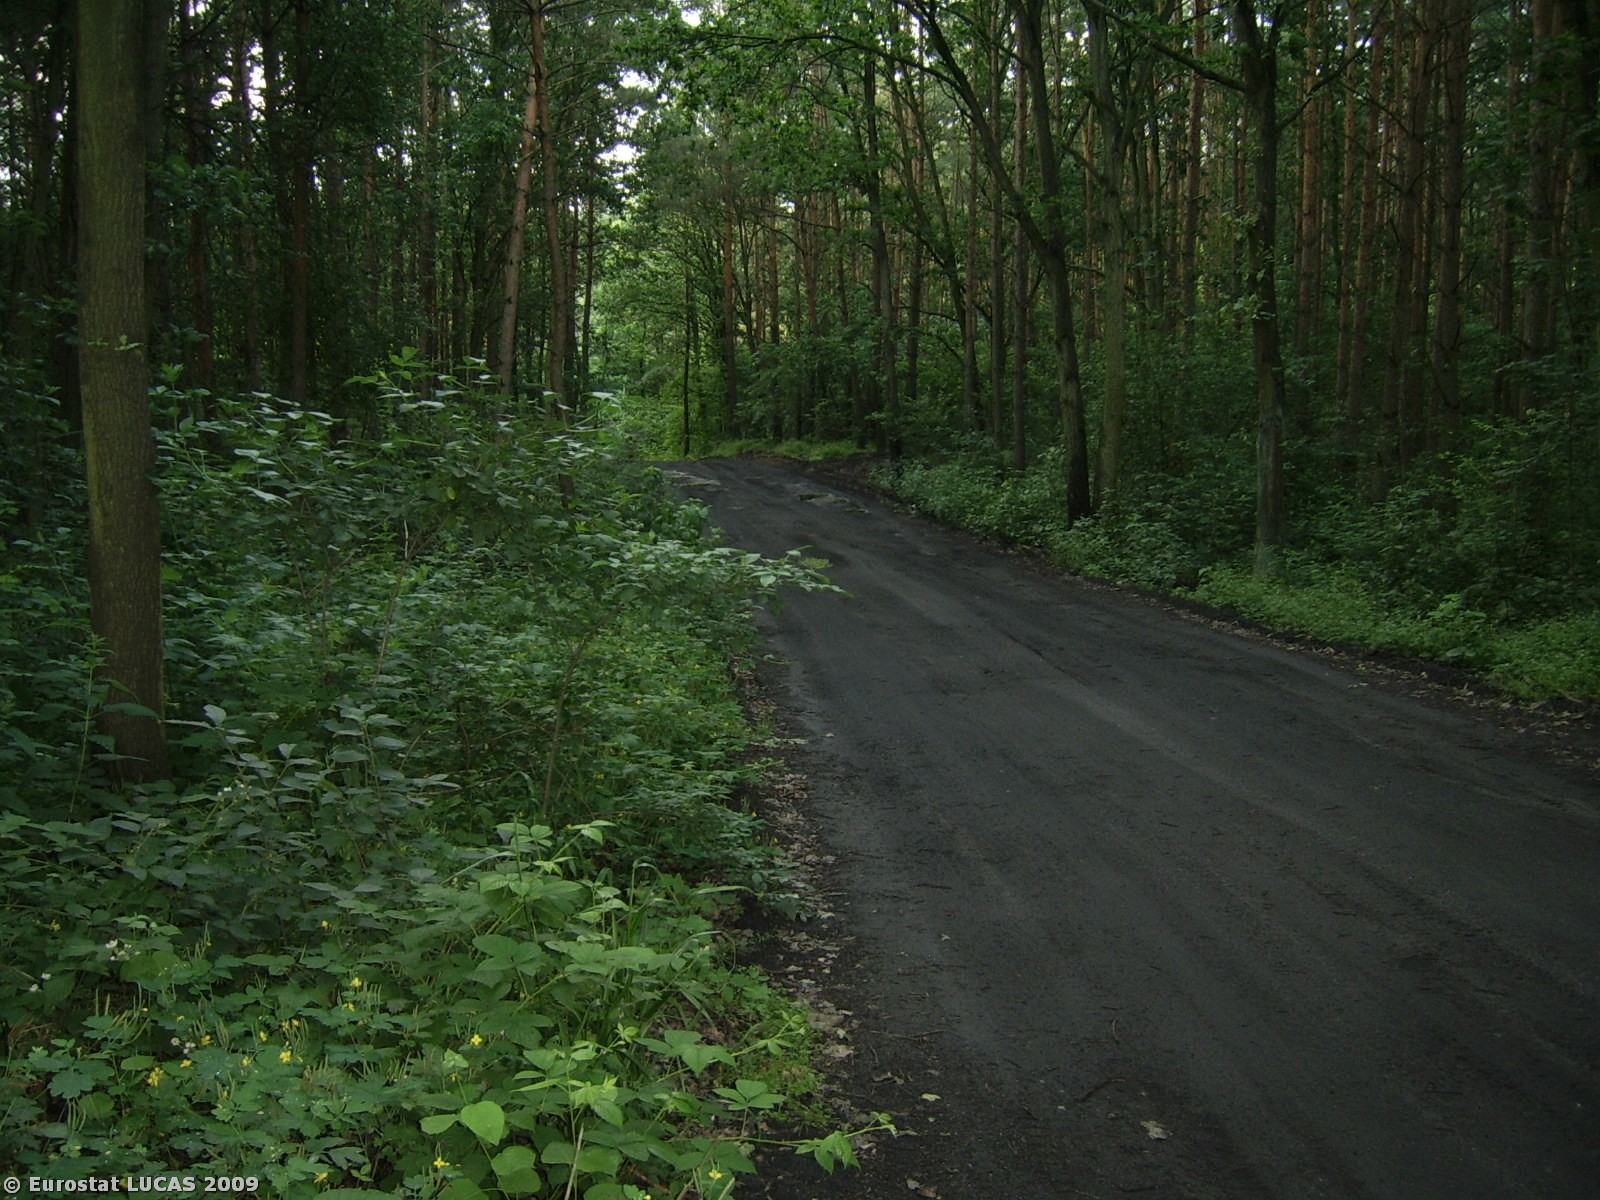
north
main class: Woodland
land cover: Mixed woodland
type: hemiboreal forest and nemoral coniferous forest and mixed broadleaved-coniferous forest
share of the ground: > 75 %
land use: Unused
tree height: > 5 m
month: July
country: PL
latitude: 53.1219
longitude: 17.6787
